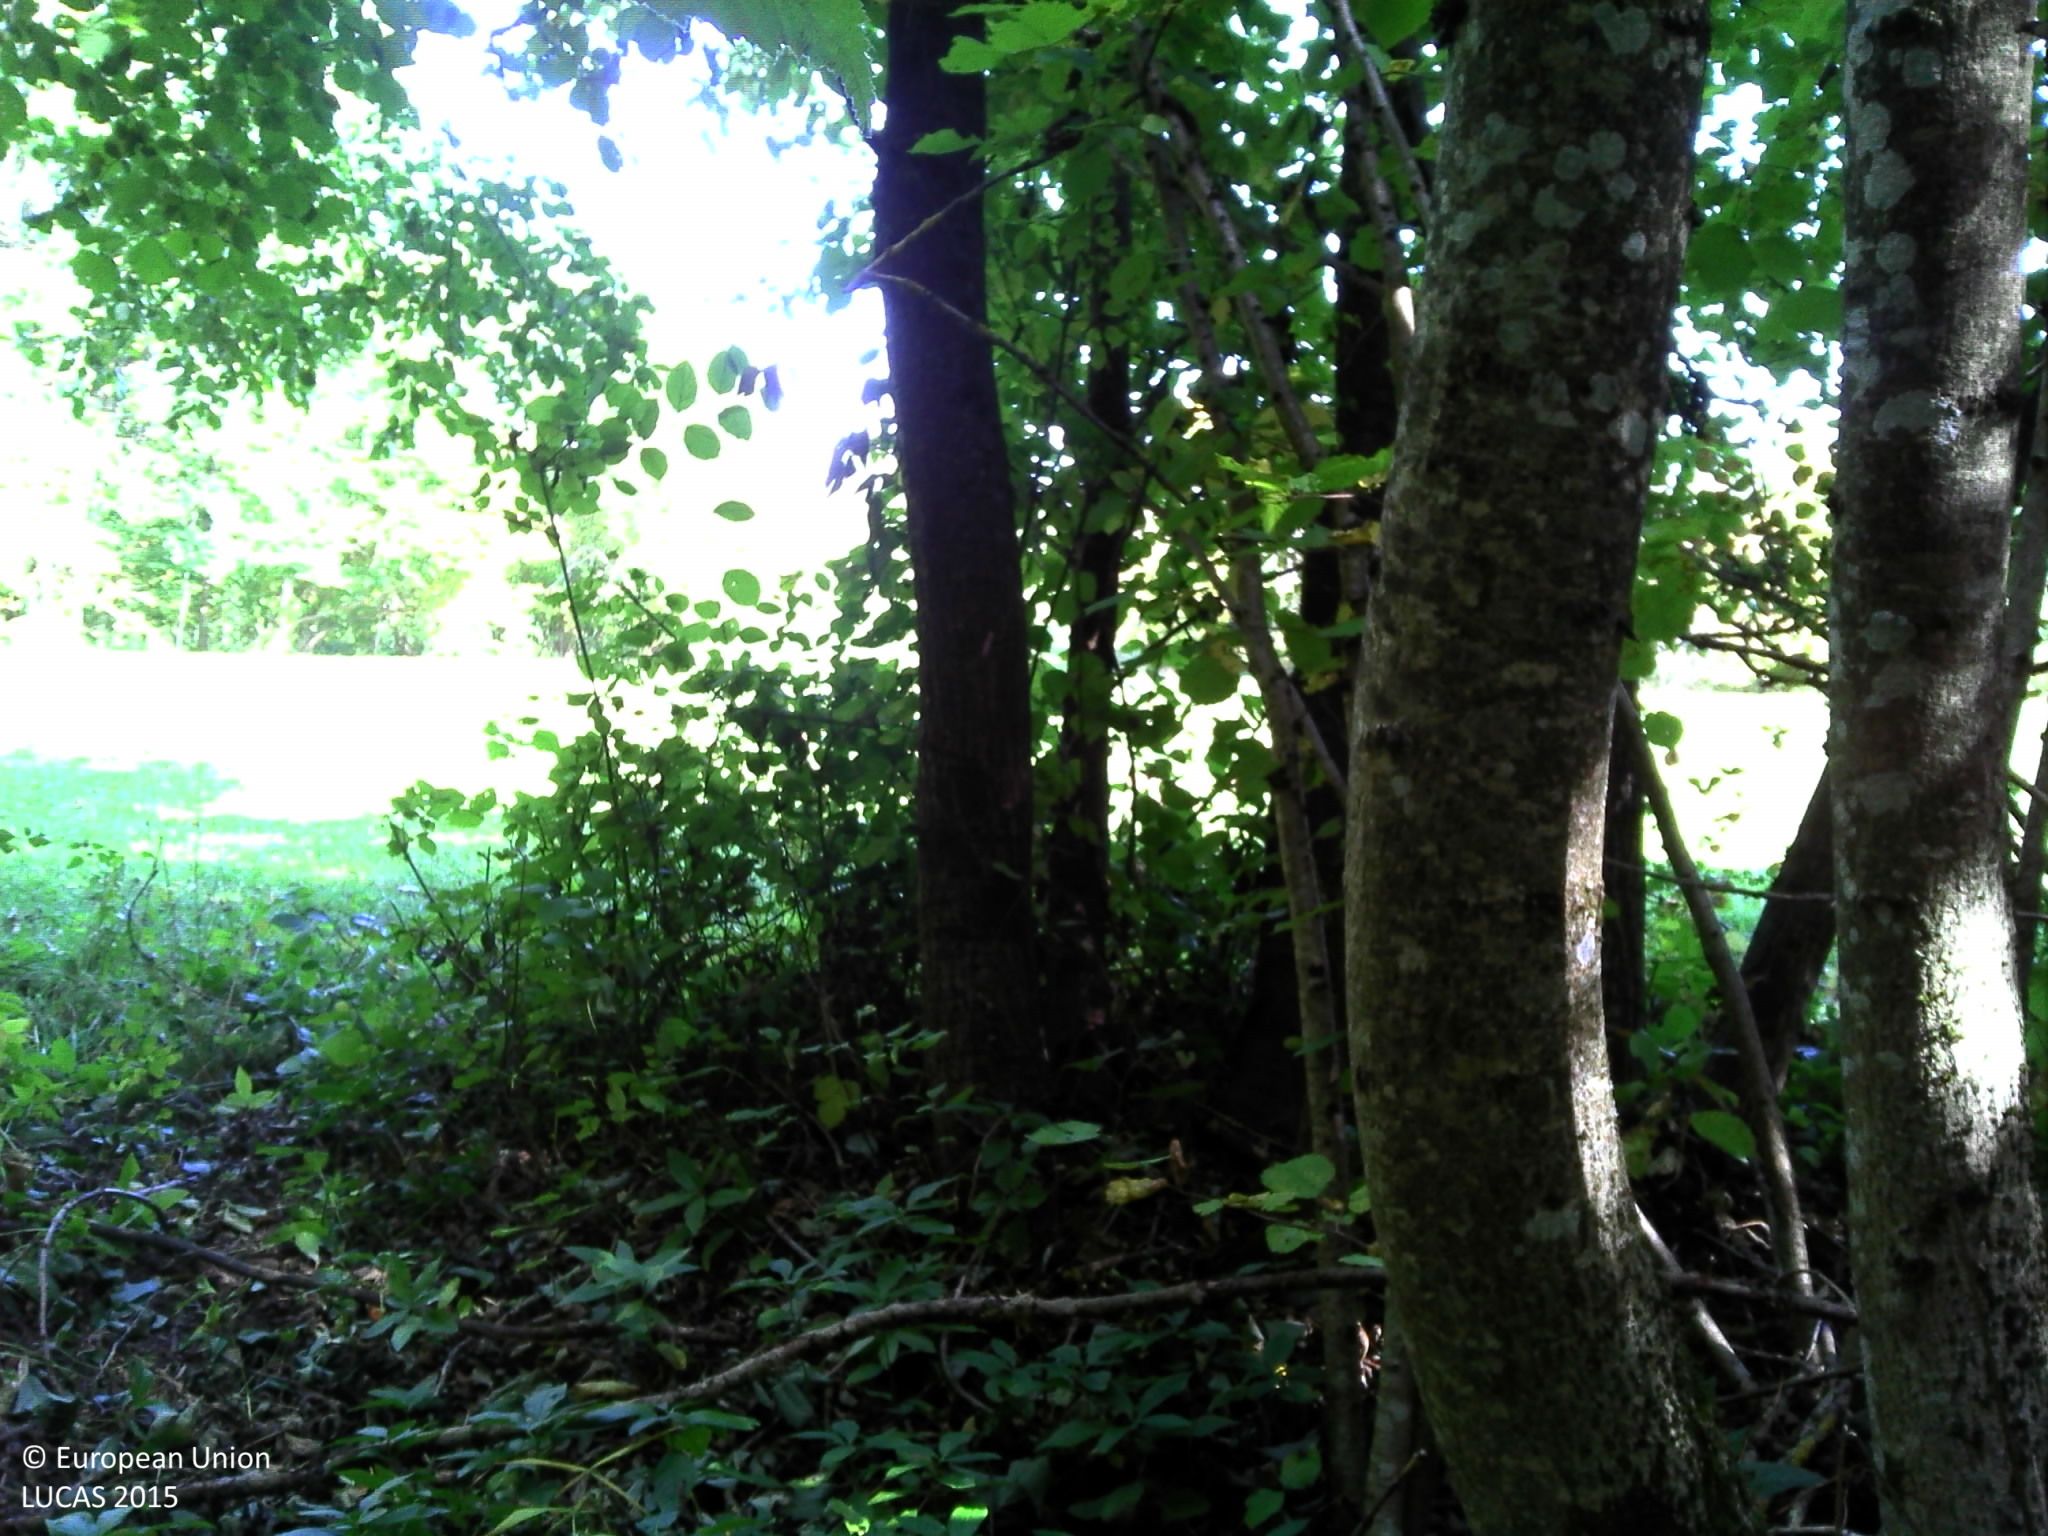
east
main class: Woodland
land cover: Broadleaved woodland
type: mesophytic deciduous forest
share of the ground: > 75 %
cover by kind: broadleaved forest trees 90 %, herbaceous plants 10 %
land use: Forestry
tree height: > 5 m
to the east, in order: Broadleaved woodland; Grassland without tree/shrub cover; Broadleaved woodland; Spontaneously vegetated surfaces; Broadleaved woodland; Grassland without tree/shrub cover
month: October
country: FR
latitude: 47.0112
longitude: 6.3849
